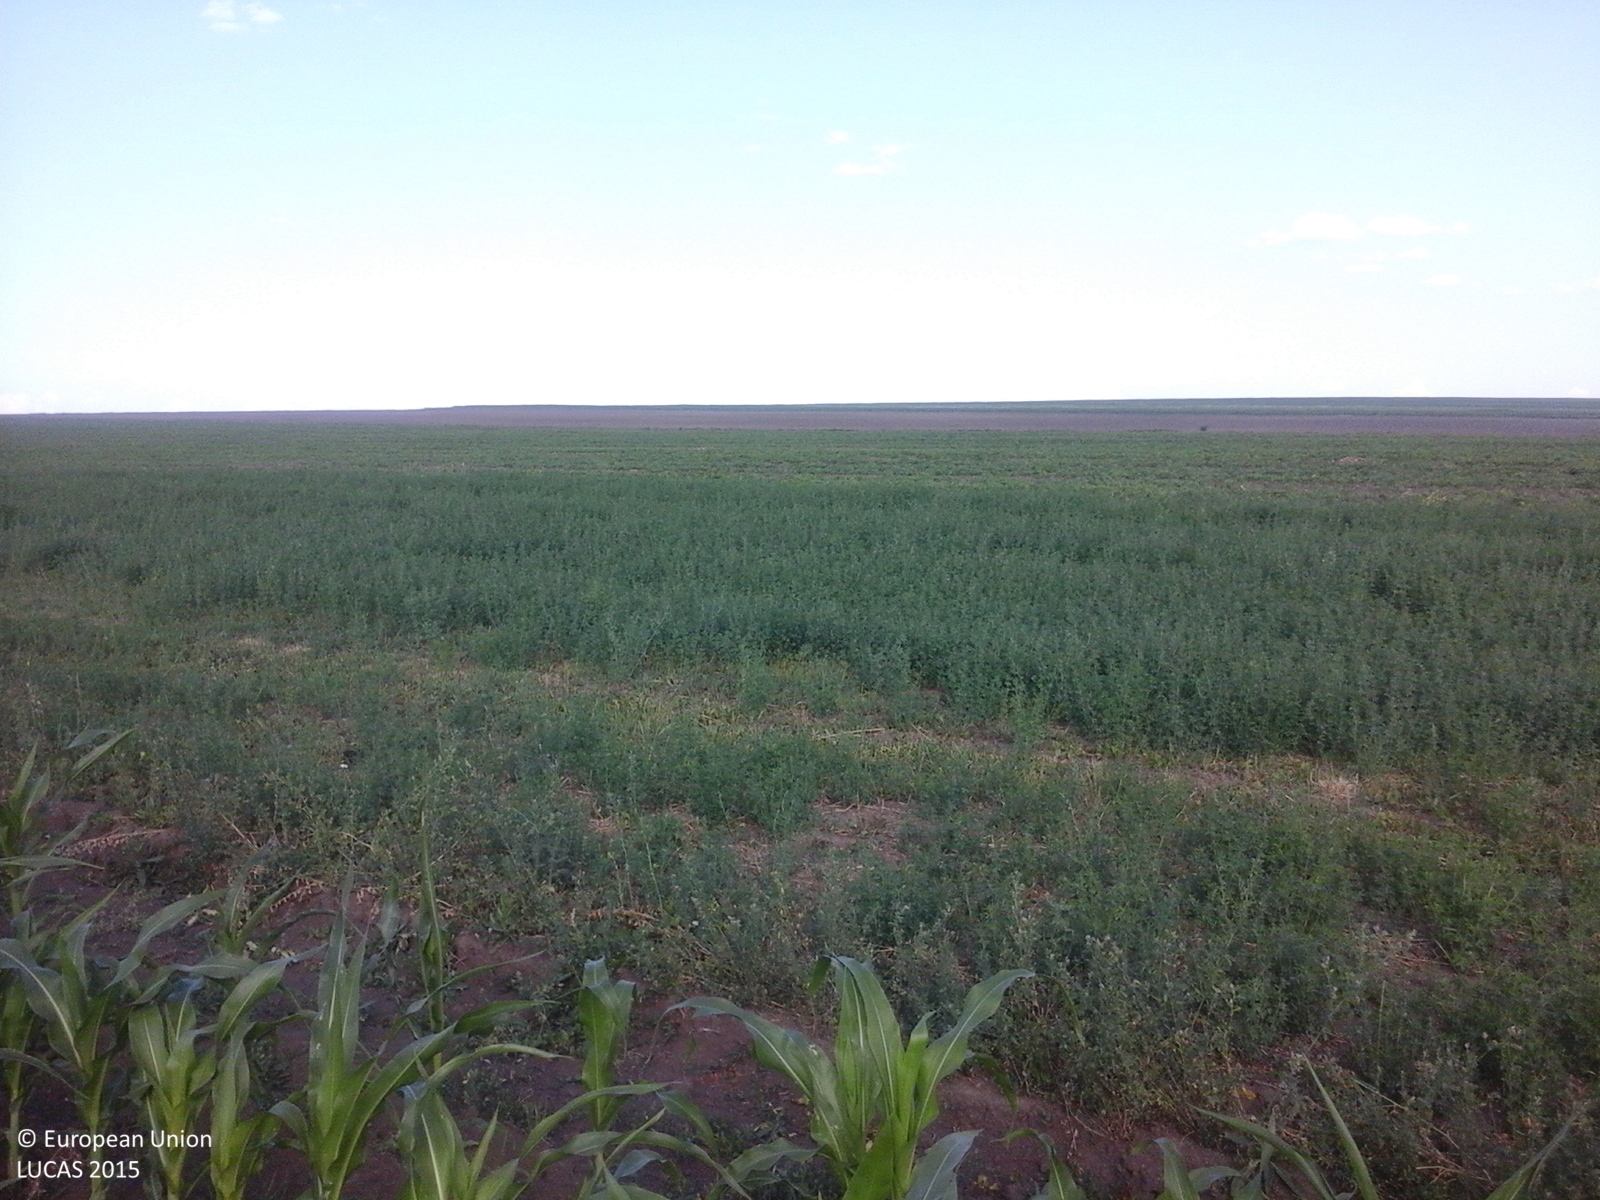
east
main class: Cropland
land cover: Maize
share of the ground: 25 - 50 %
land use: Agriculture (excluding fallow land and kitchen gardens)
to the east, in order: Maize; Lucerne; Tracks; Soya; Other bare soil
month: June
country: RO
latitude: 47.7081
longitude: 26.8259
